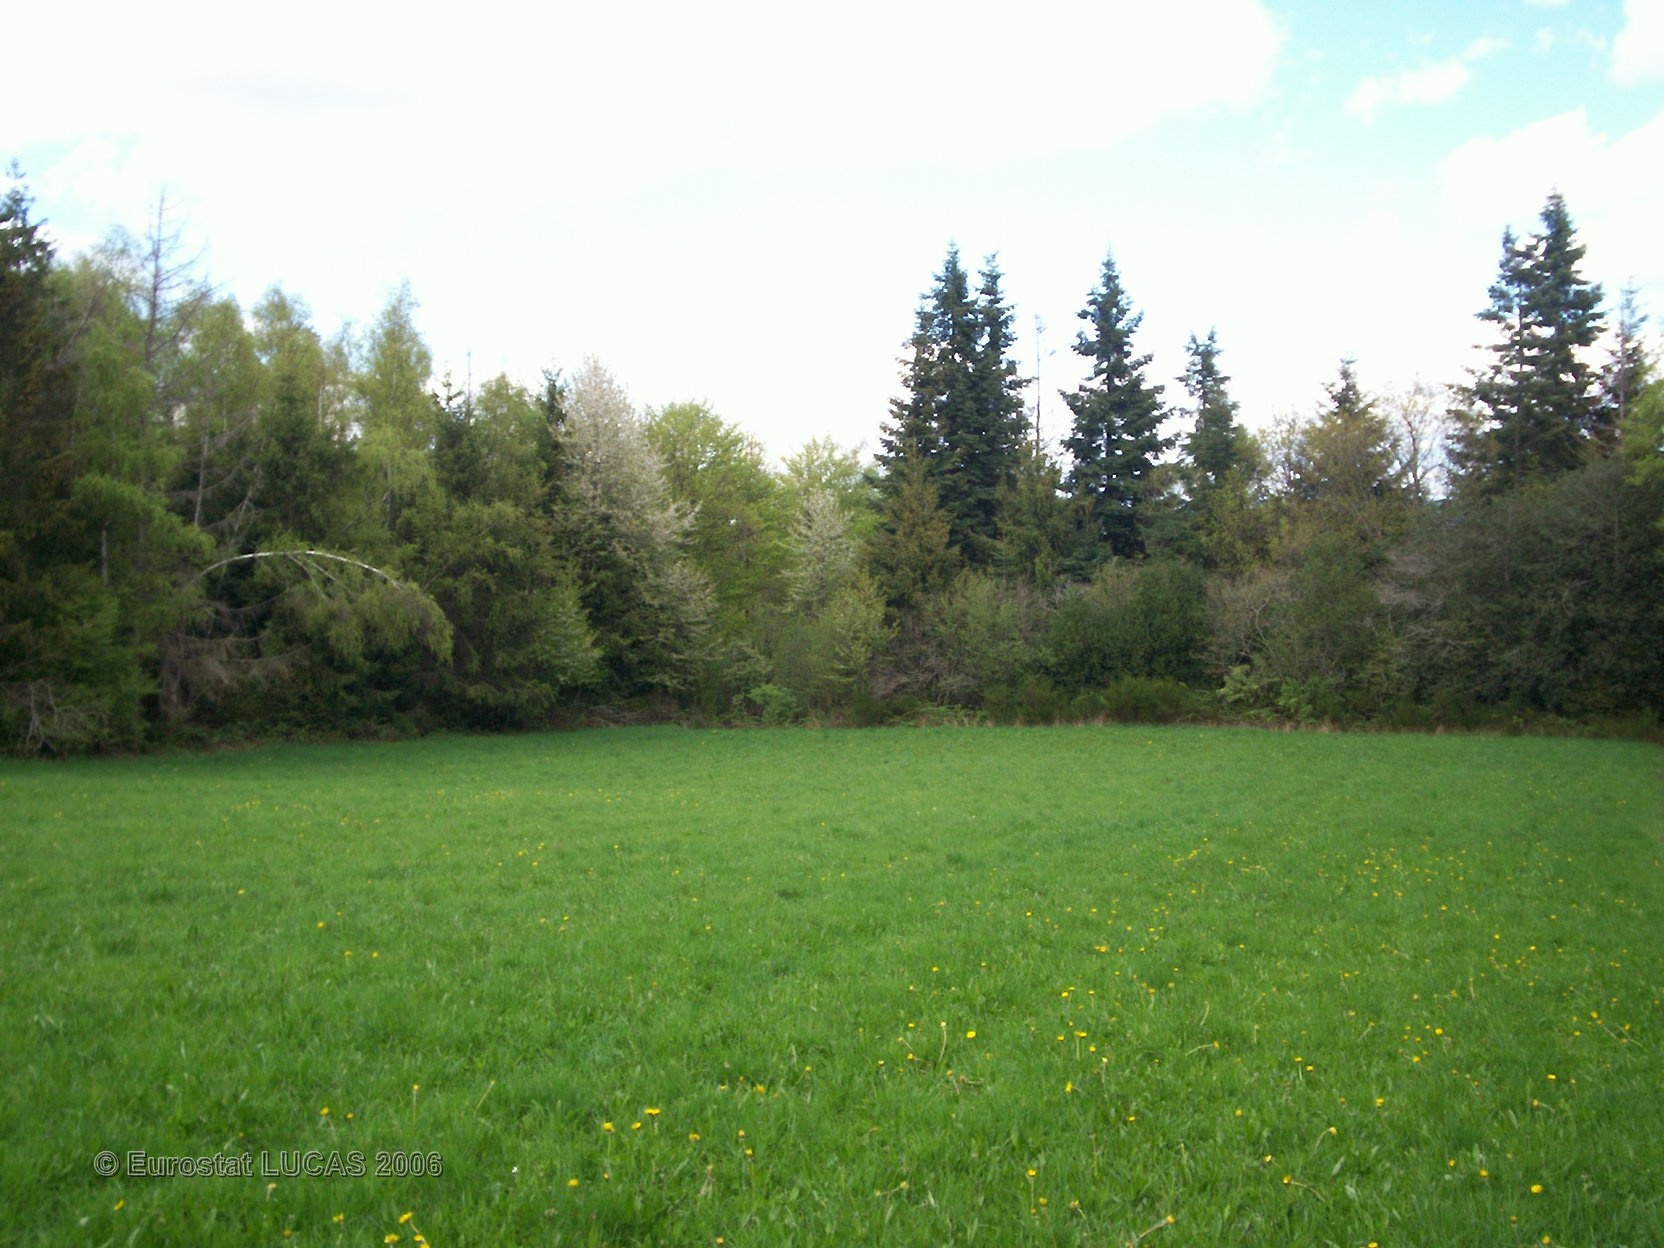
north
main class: Grassland
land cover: Grassland without tree/shrub cover
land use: Agriculture (excluding fallow land and kitchen gardens)
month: May
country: FR
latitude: 45.1664
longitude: 3.3230
